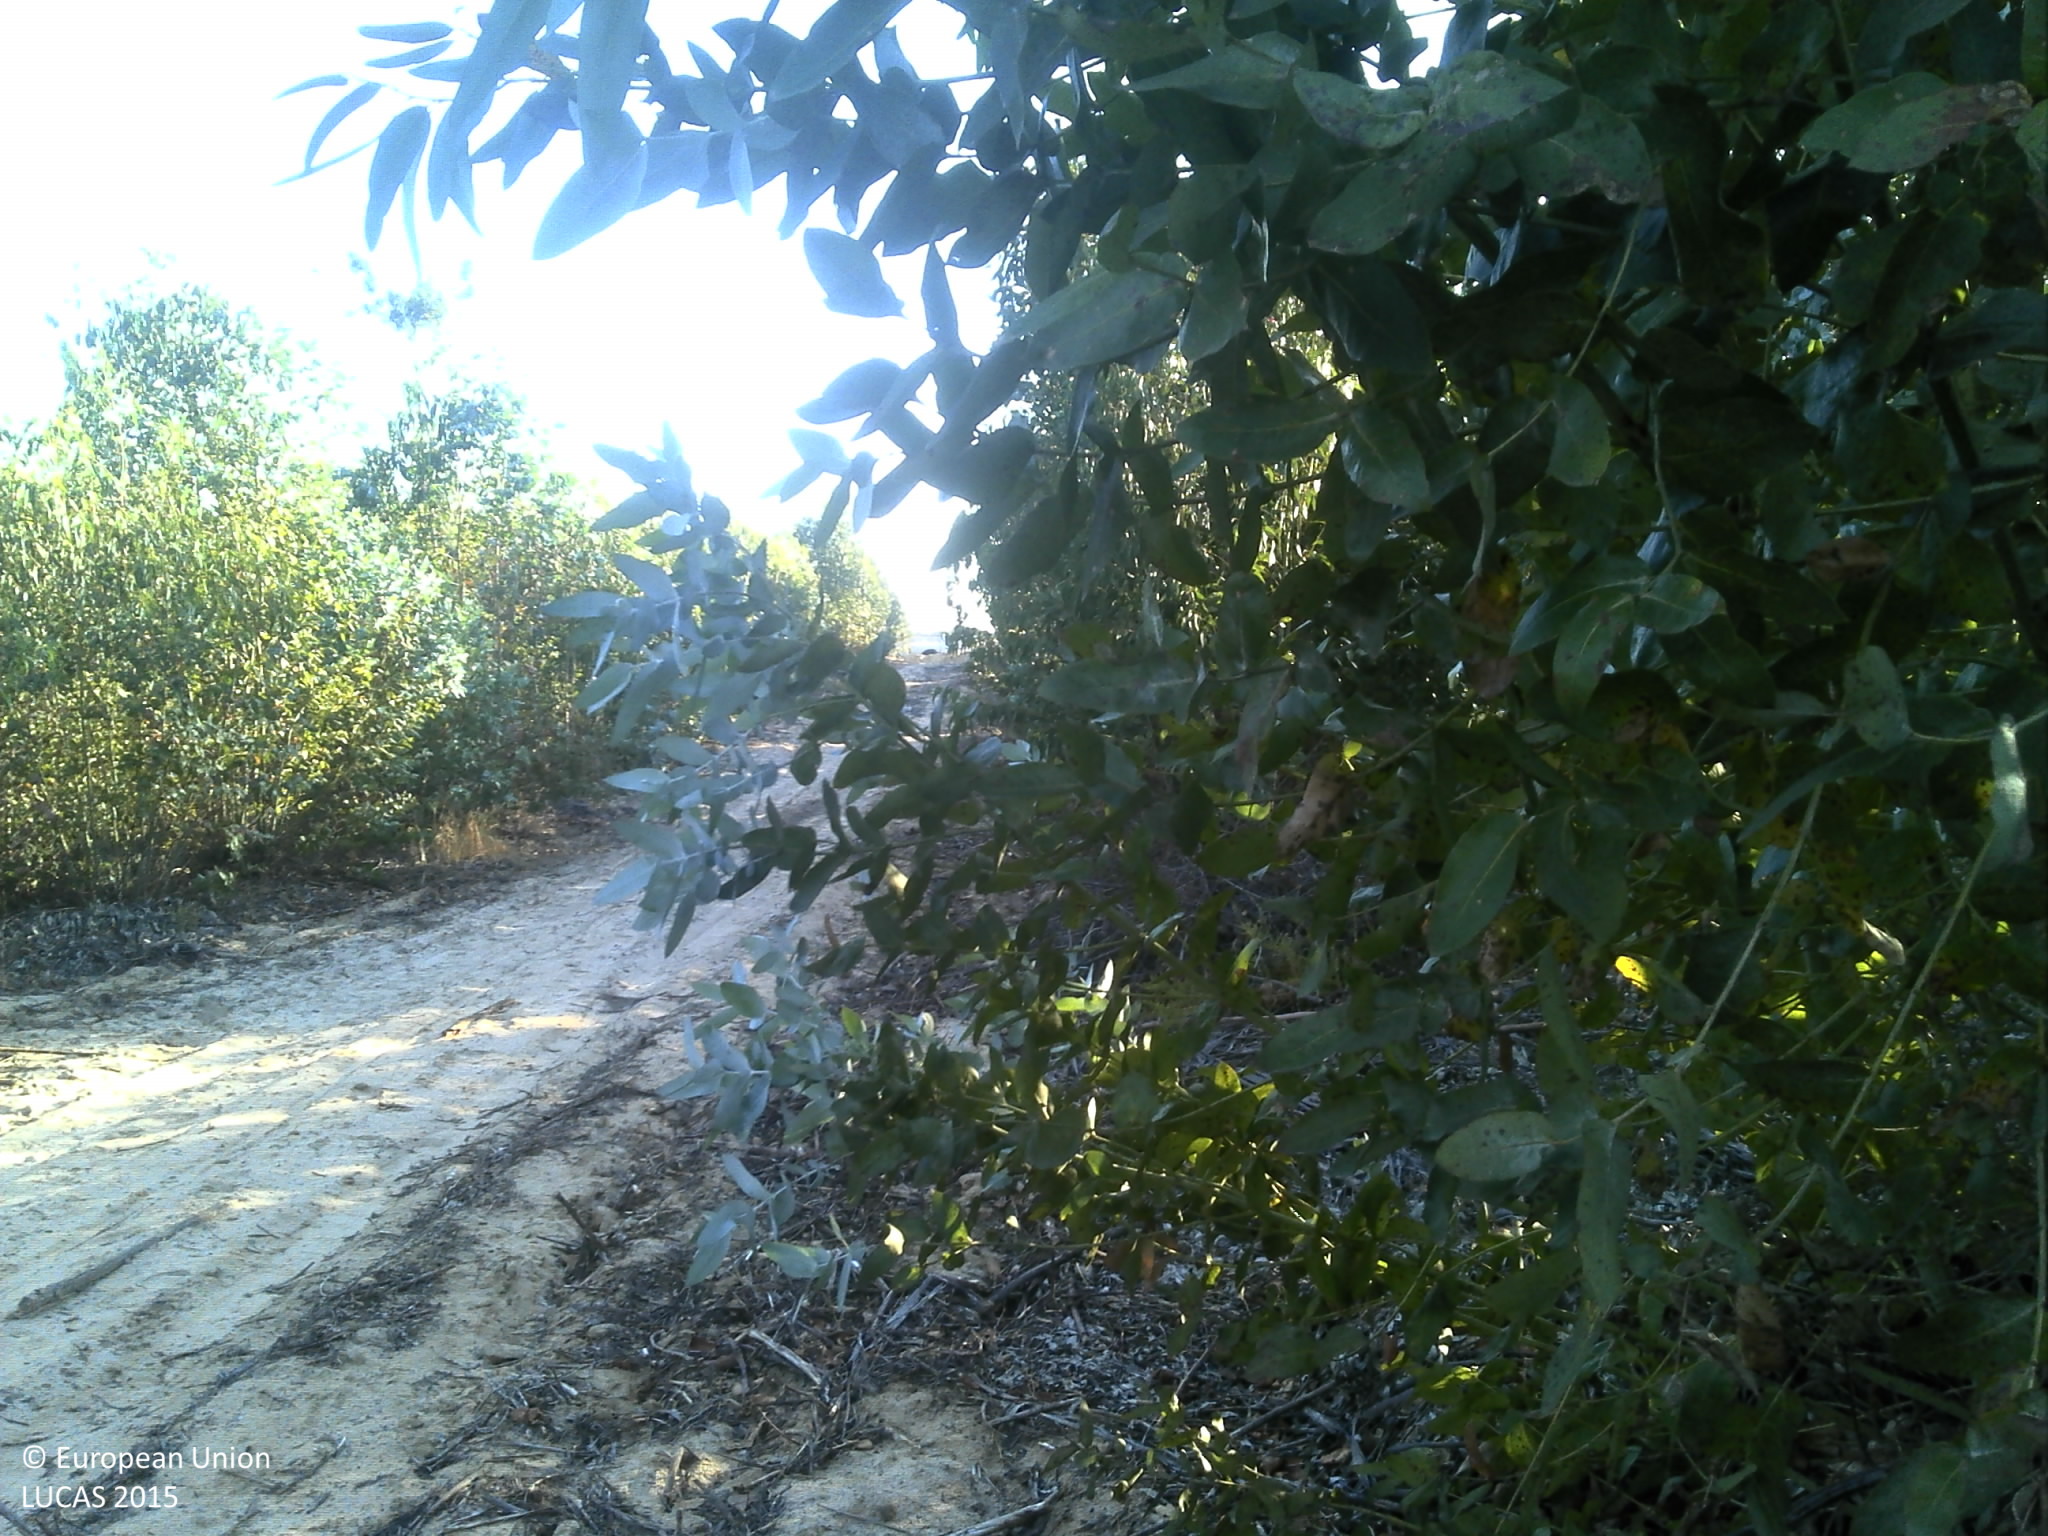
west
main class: Woodland
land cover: Broadleaved woodland
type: exotic forest
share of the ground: 50 - 75 %
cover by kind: broadleaved forest trees 70 %, unconsolidated bare surface 30 %
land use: Forestry
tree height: > 5 m
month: June
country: PT
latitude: 39.0776
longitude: -8.7155
